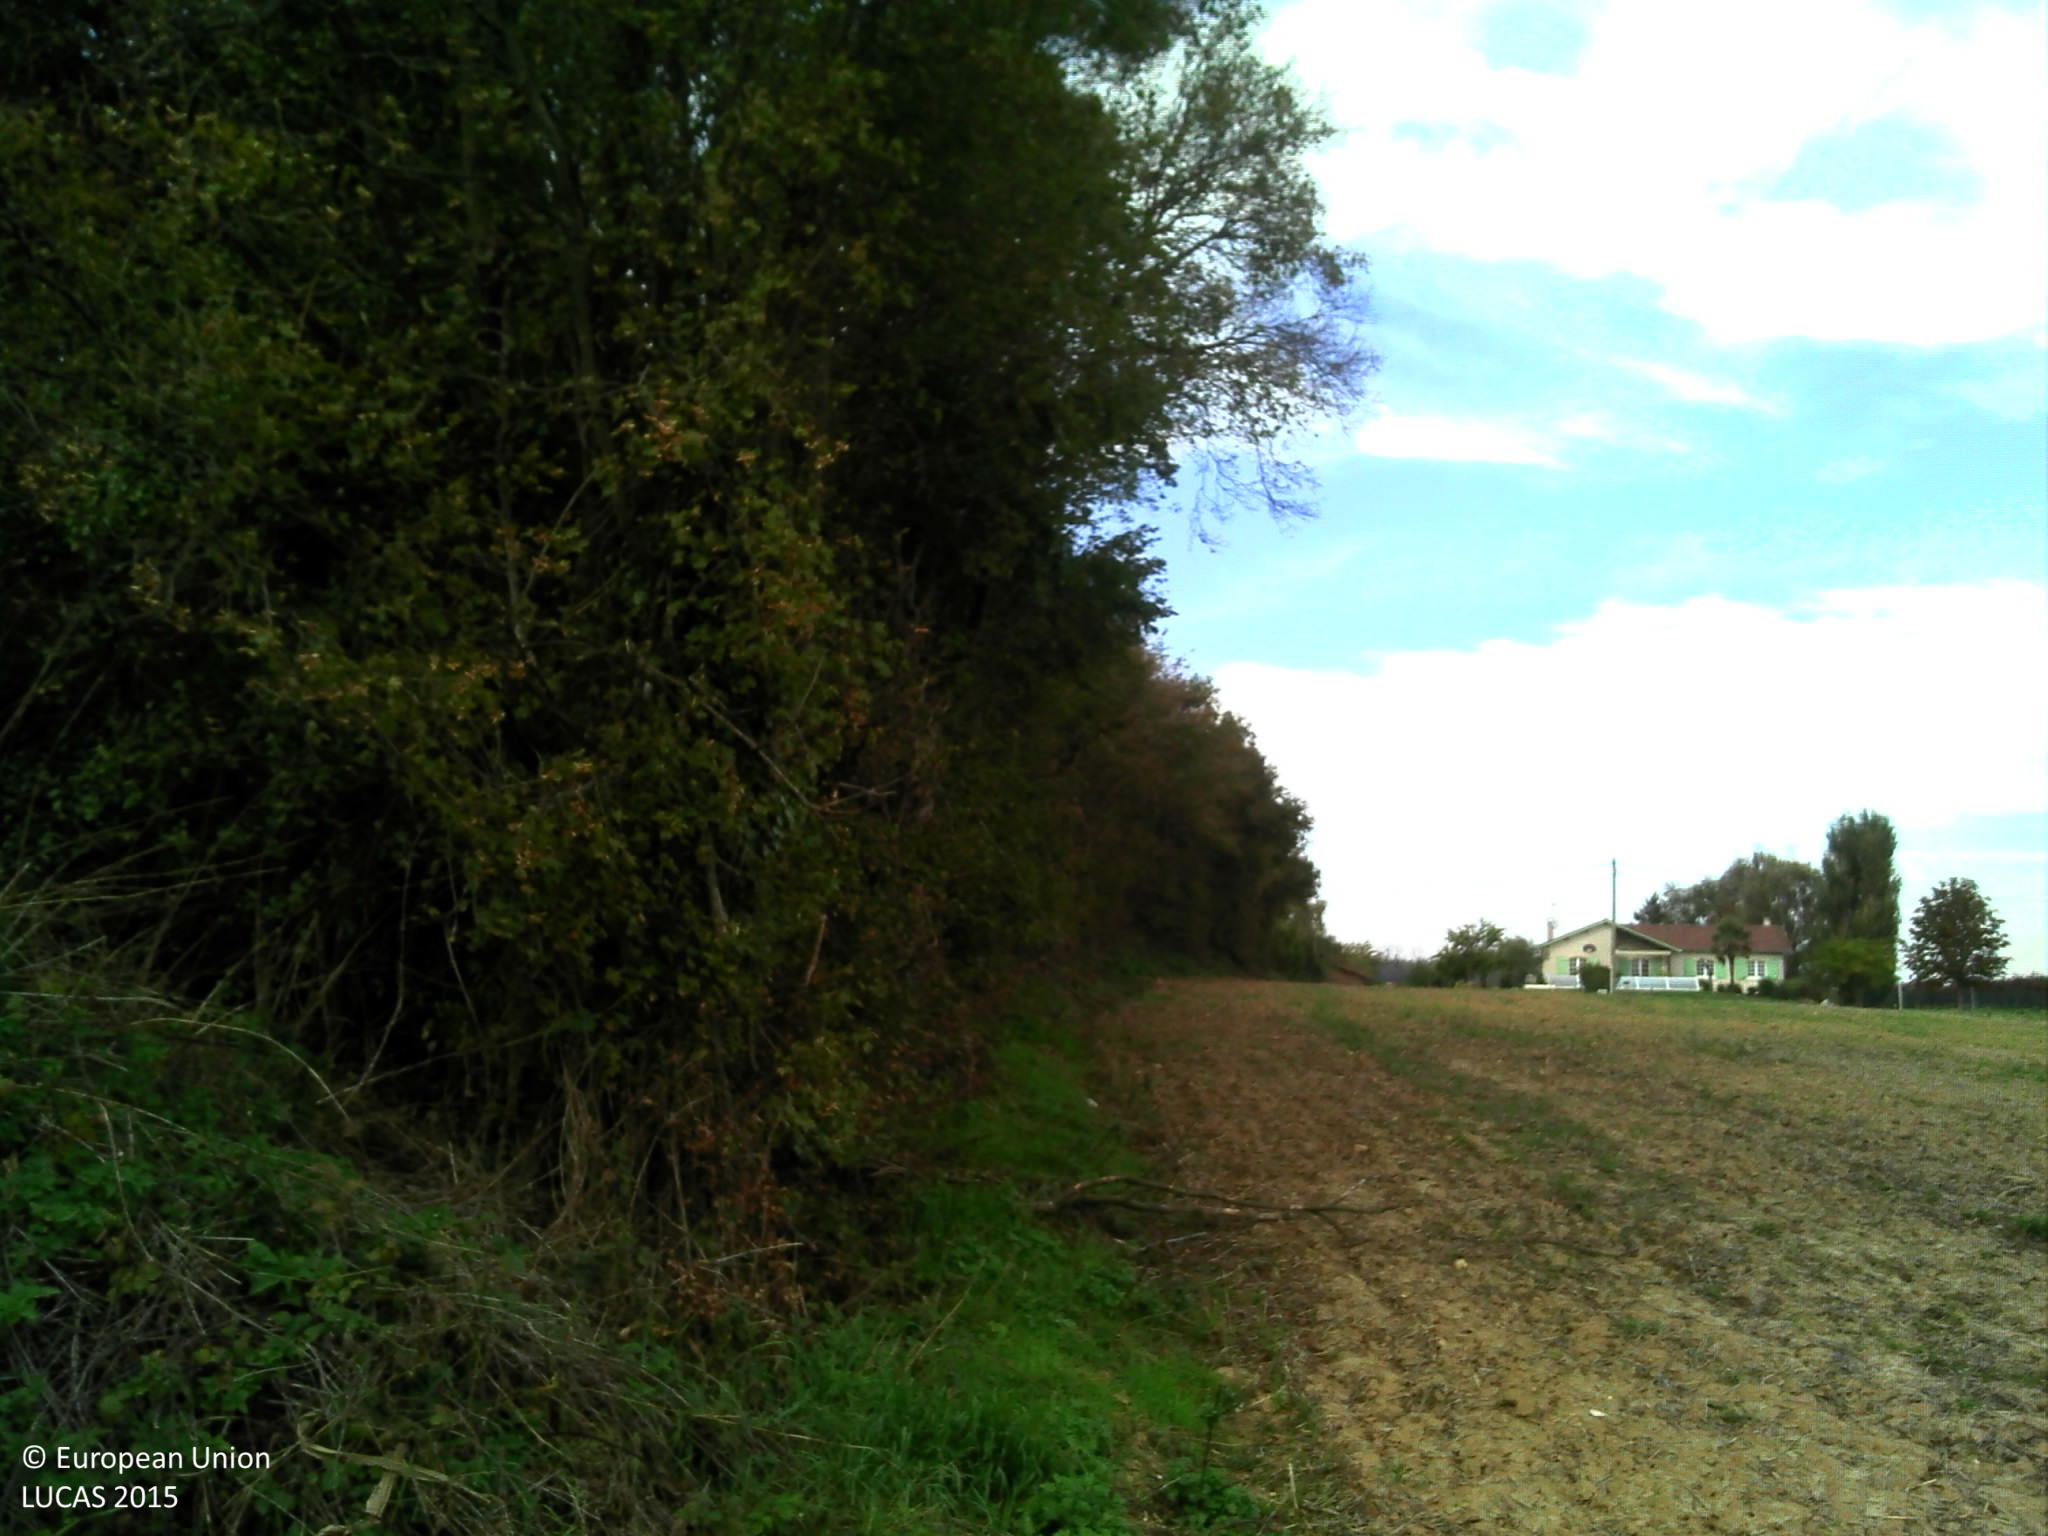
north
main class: Cropland
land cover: Common wheat
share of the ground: > 75 %
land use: Agriculture (excluding fallow land and kitchen gardens)
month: October
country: FR
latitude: 45.9387
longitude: 4.8568
